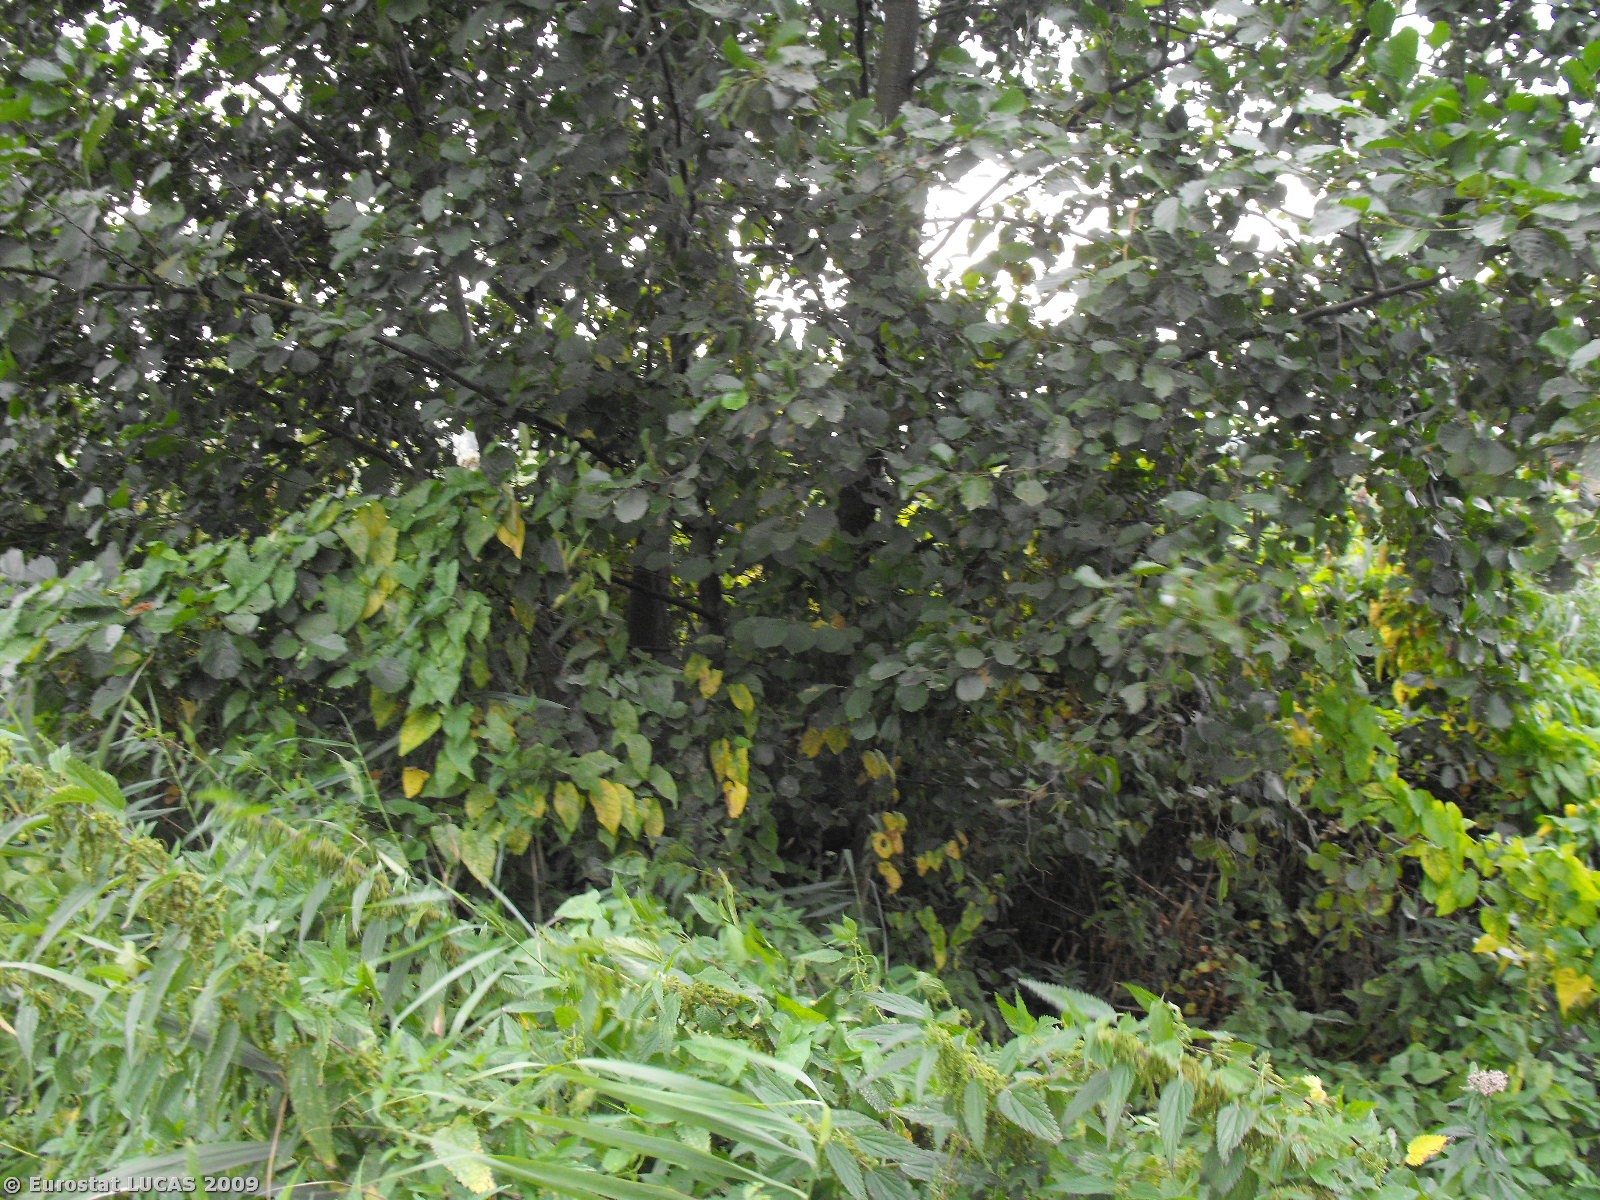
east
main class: Grassland
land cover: Spontaneously vegetated surfaces
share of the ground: > 75 %
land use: Unused
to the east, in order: Spontaneously vegetated surfaces; Shrubland with sparse tree cover; Lines of trees; Grassland with sparse tree/shrub cover; Inland running water
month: September
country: PL
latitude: 52.8925
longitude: 16.3534
